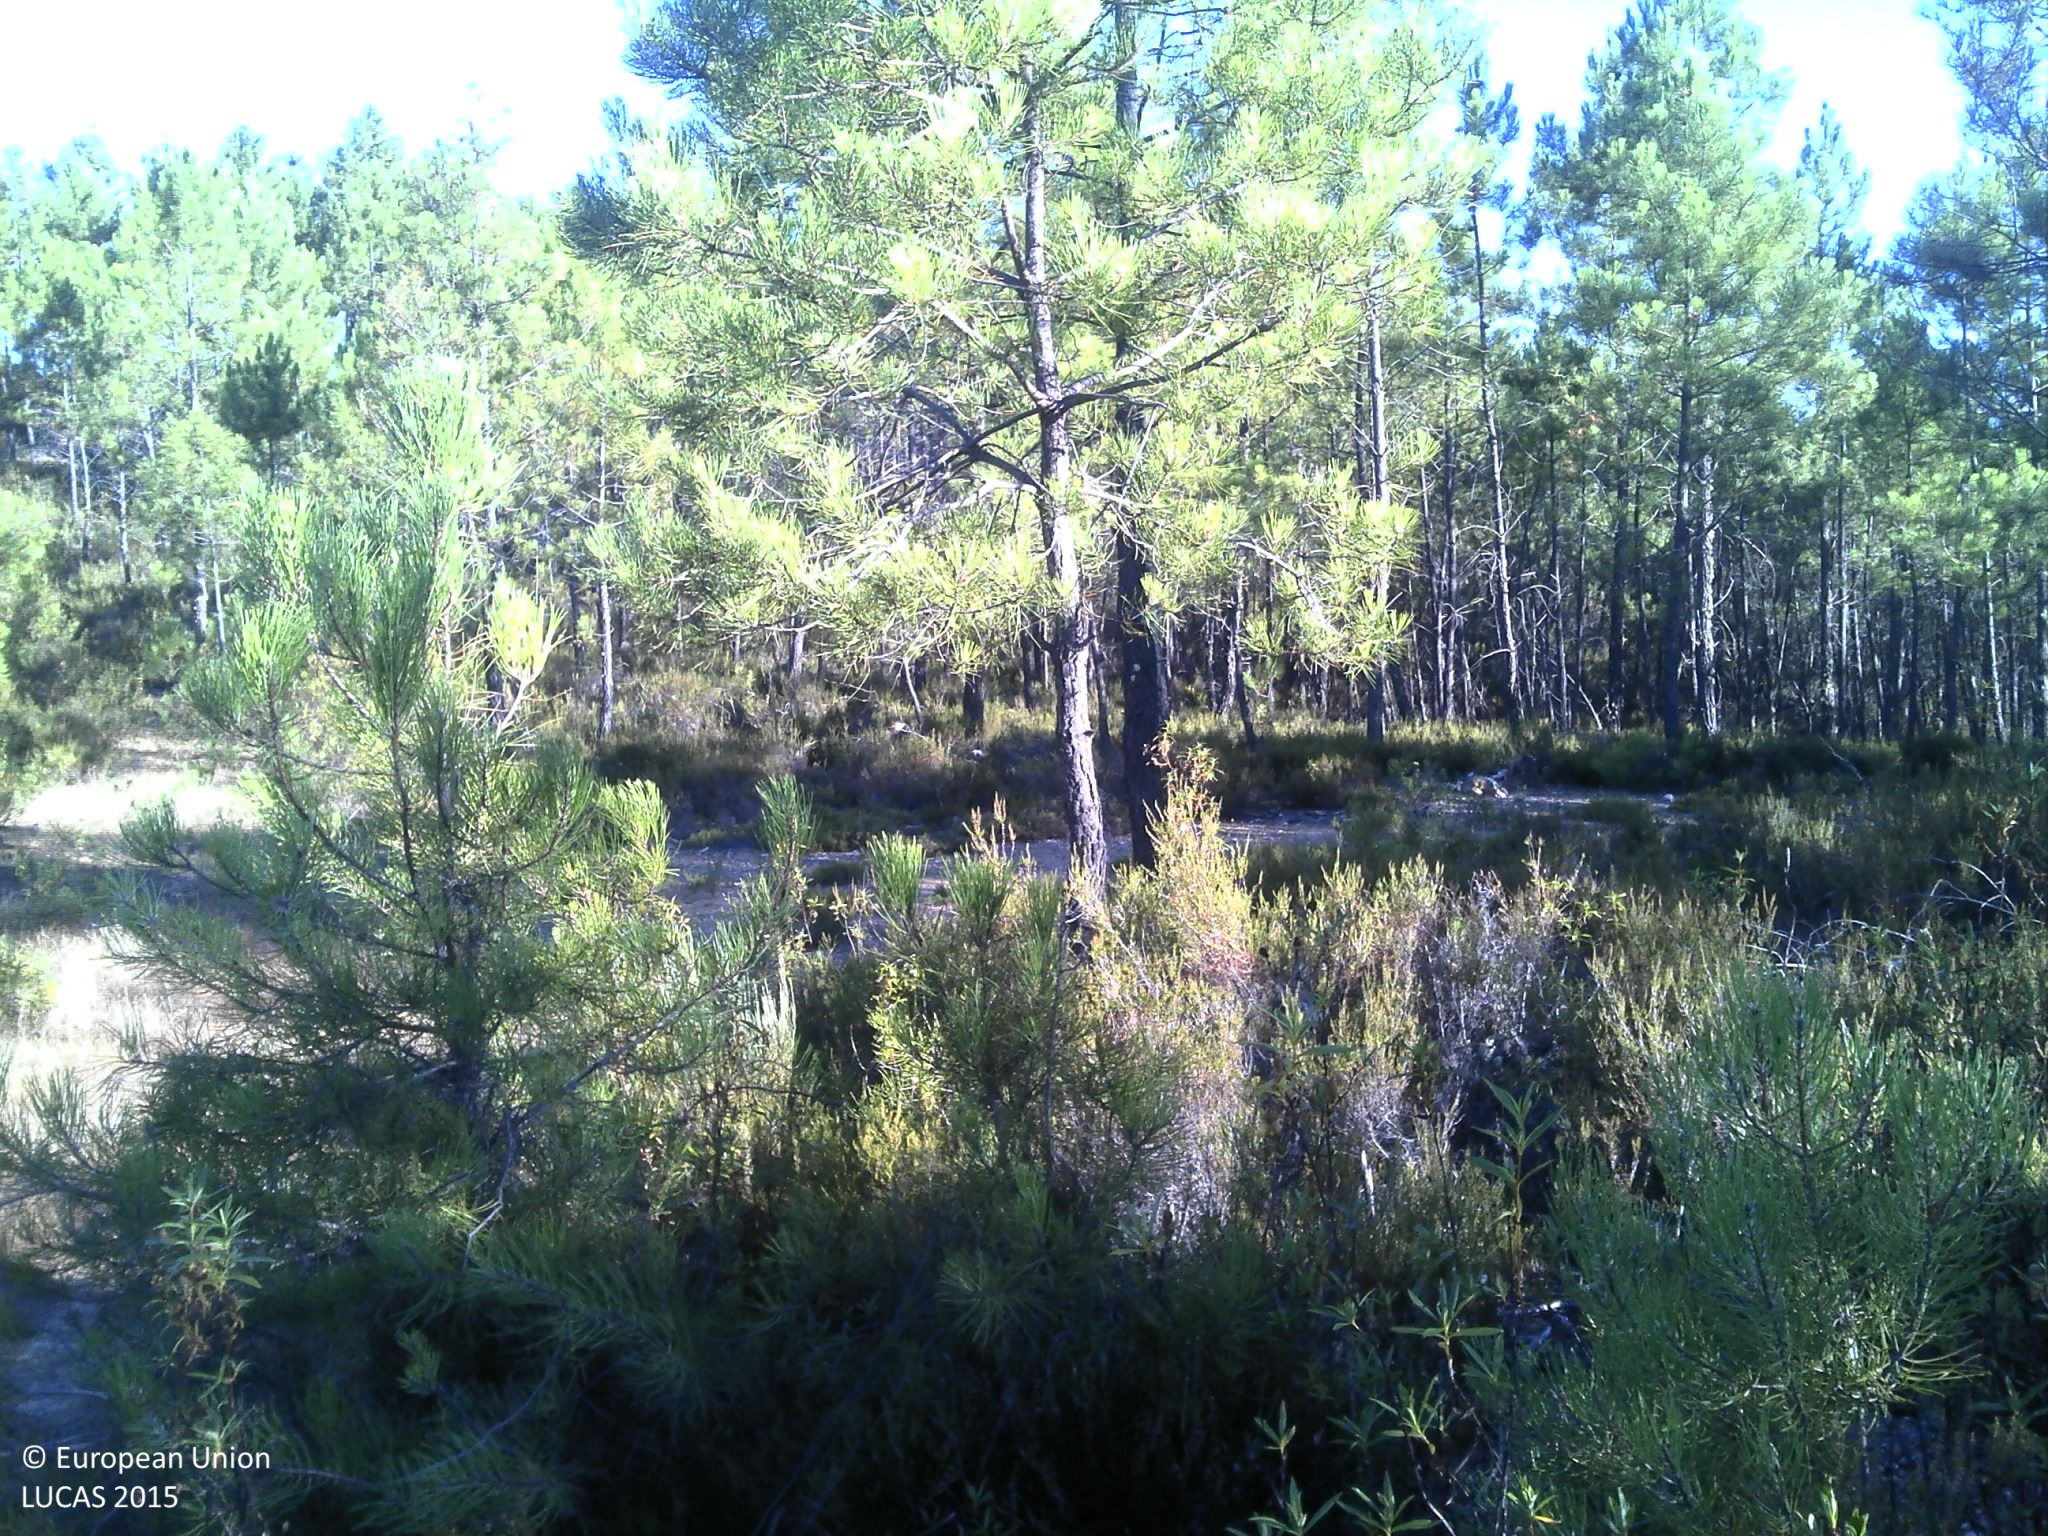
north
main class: Woodland
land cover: Pine dominated coniferous woodland
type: coniferous forest of the mediterranean region
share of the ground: 50 - 75 %
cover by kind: coniferous forest trees 70 %, shrubs 20 %, unconsolidated bare surface 5 %
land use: Forestry
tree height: > 5 m
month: July
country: PT
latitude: 39.9890
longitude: -7.6135
